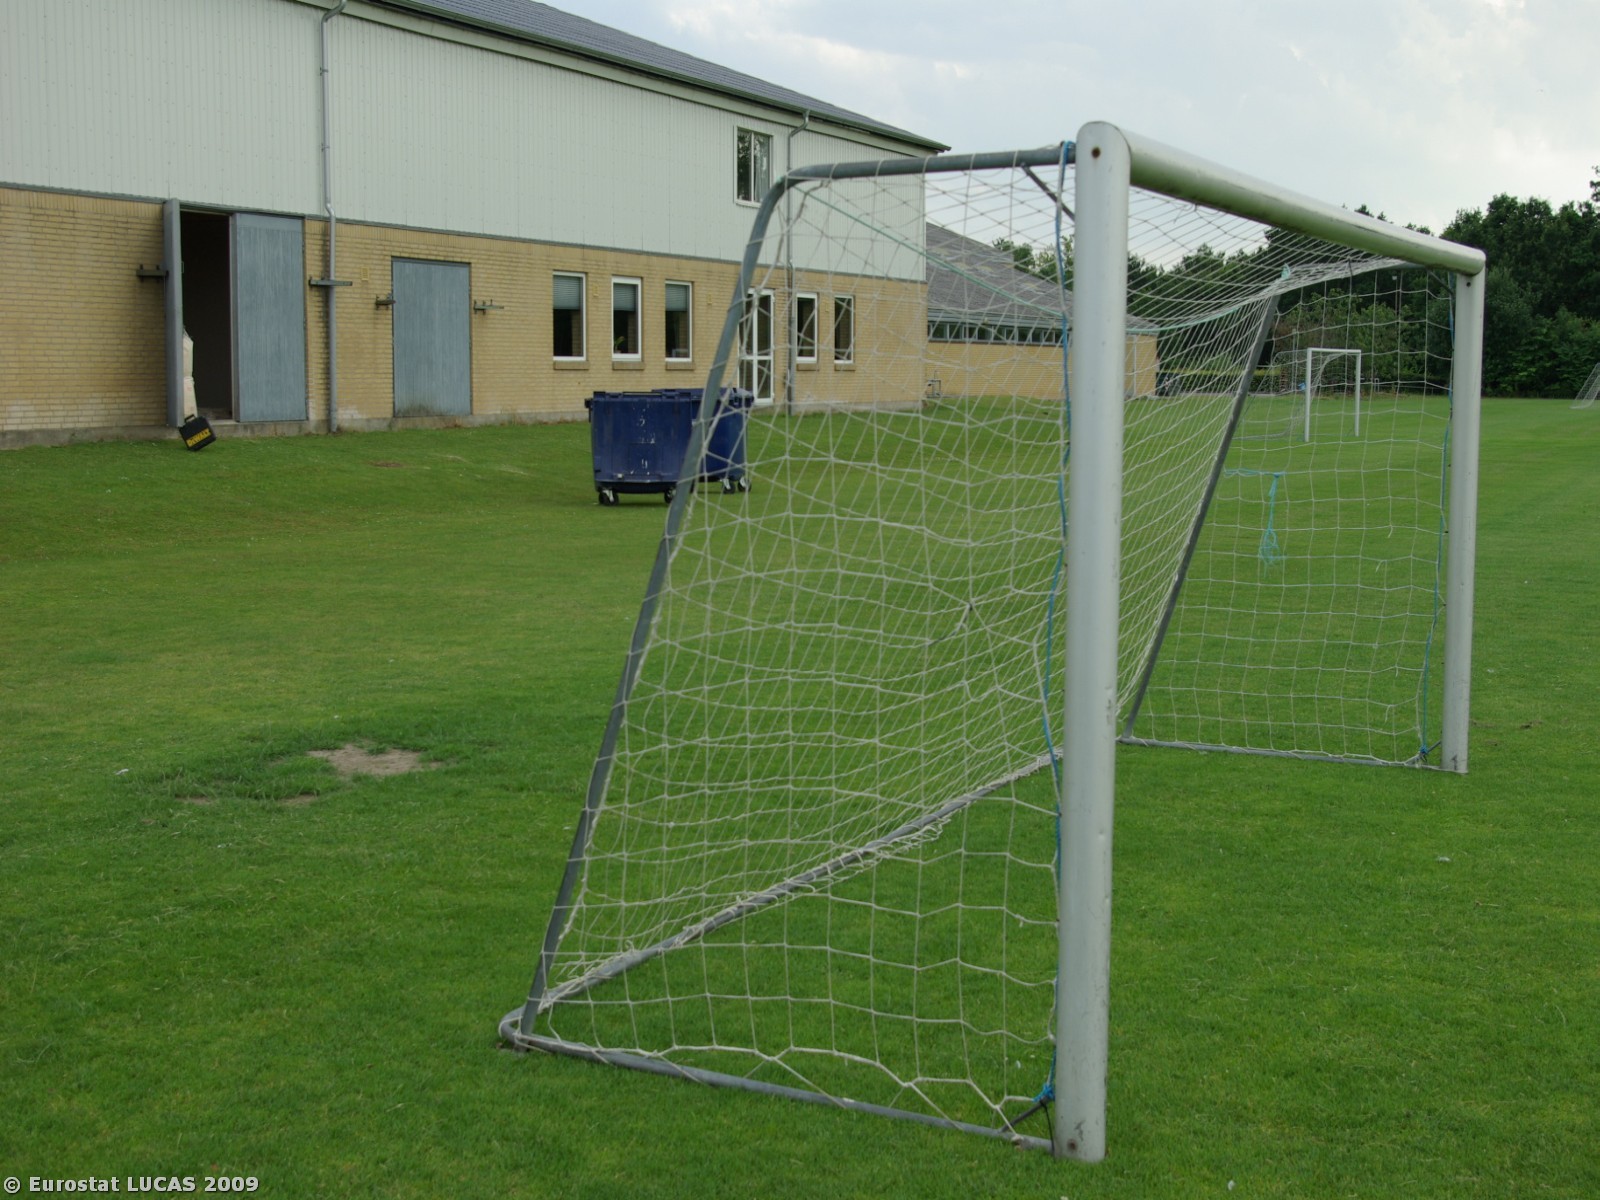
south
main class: Grassland
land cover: Grassland without tree/shrub cover
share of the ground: > 75 %
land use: Sport
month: July
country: DK
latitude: 55.0551
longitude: 9.7654
